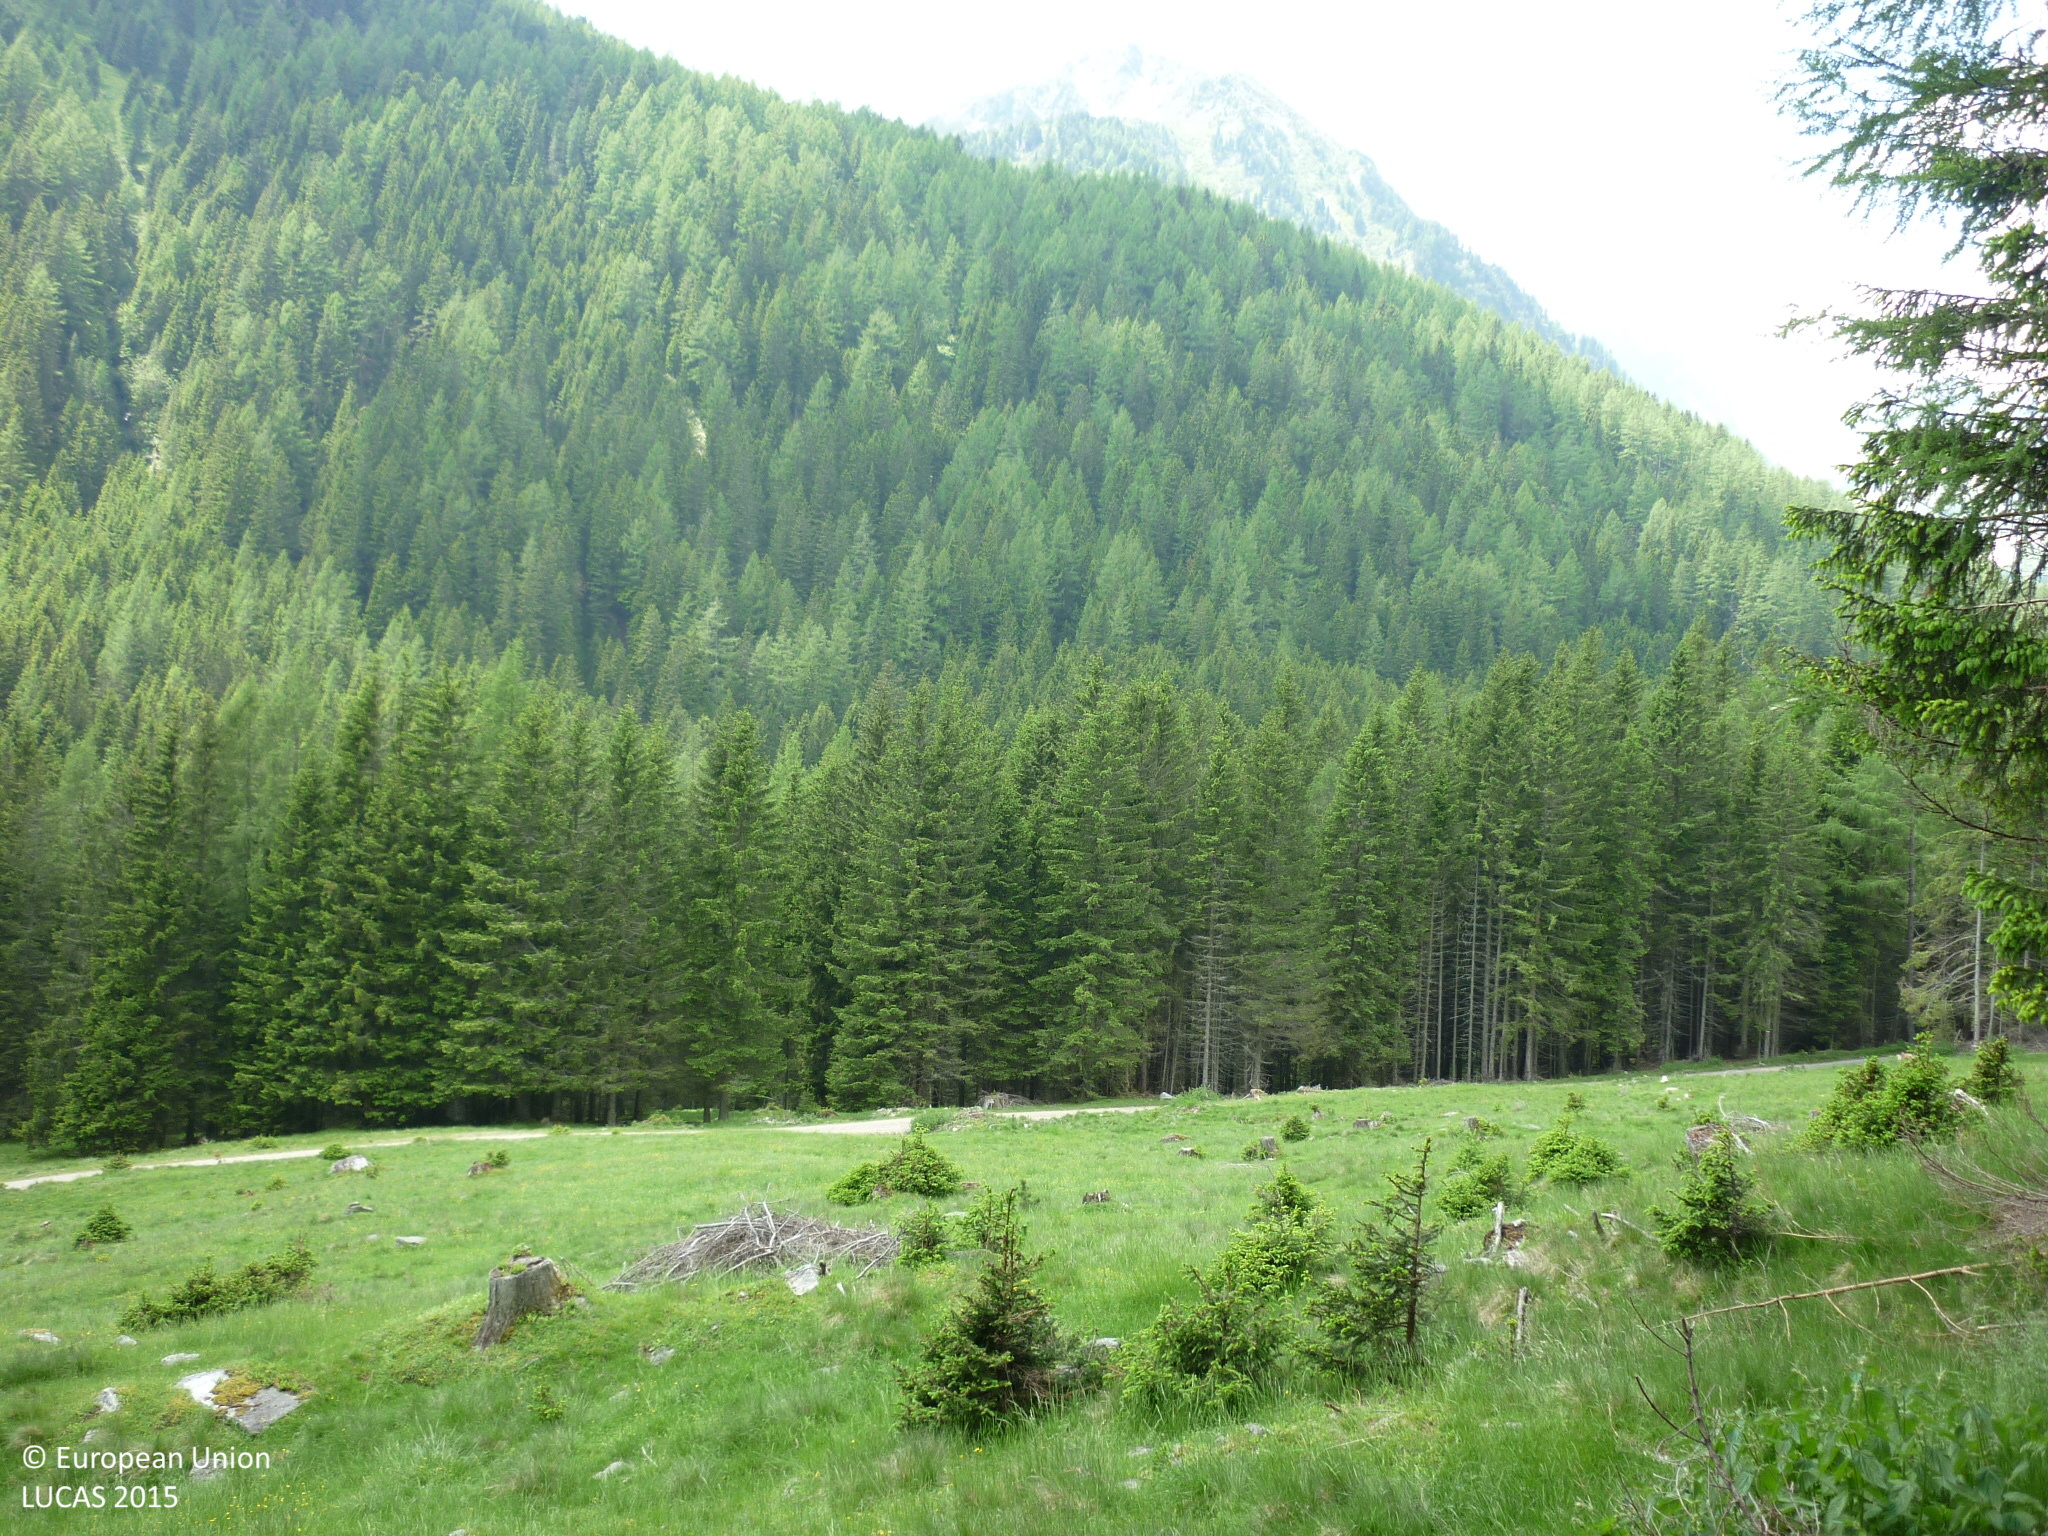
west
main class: Woodland
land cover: Spruce dominated coniferous woodland
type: alpine coniferous forest
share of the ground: > 75 %
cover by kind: coniferous forest trees 90 %, herbaceous plants 5 %, lichens and mosses 5 %
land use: Forestry
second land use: Amenities, museums, leisure
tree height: > 5 m
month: June
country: AT
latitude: 47.2329
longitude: 13.9740
